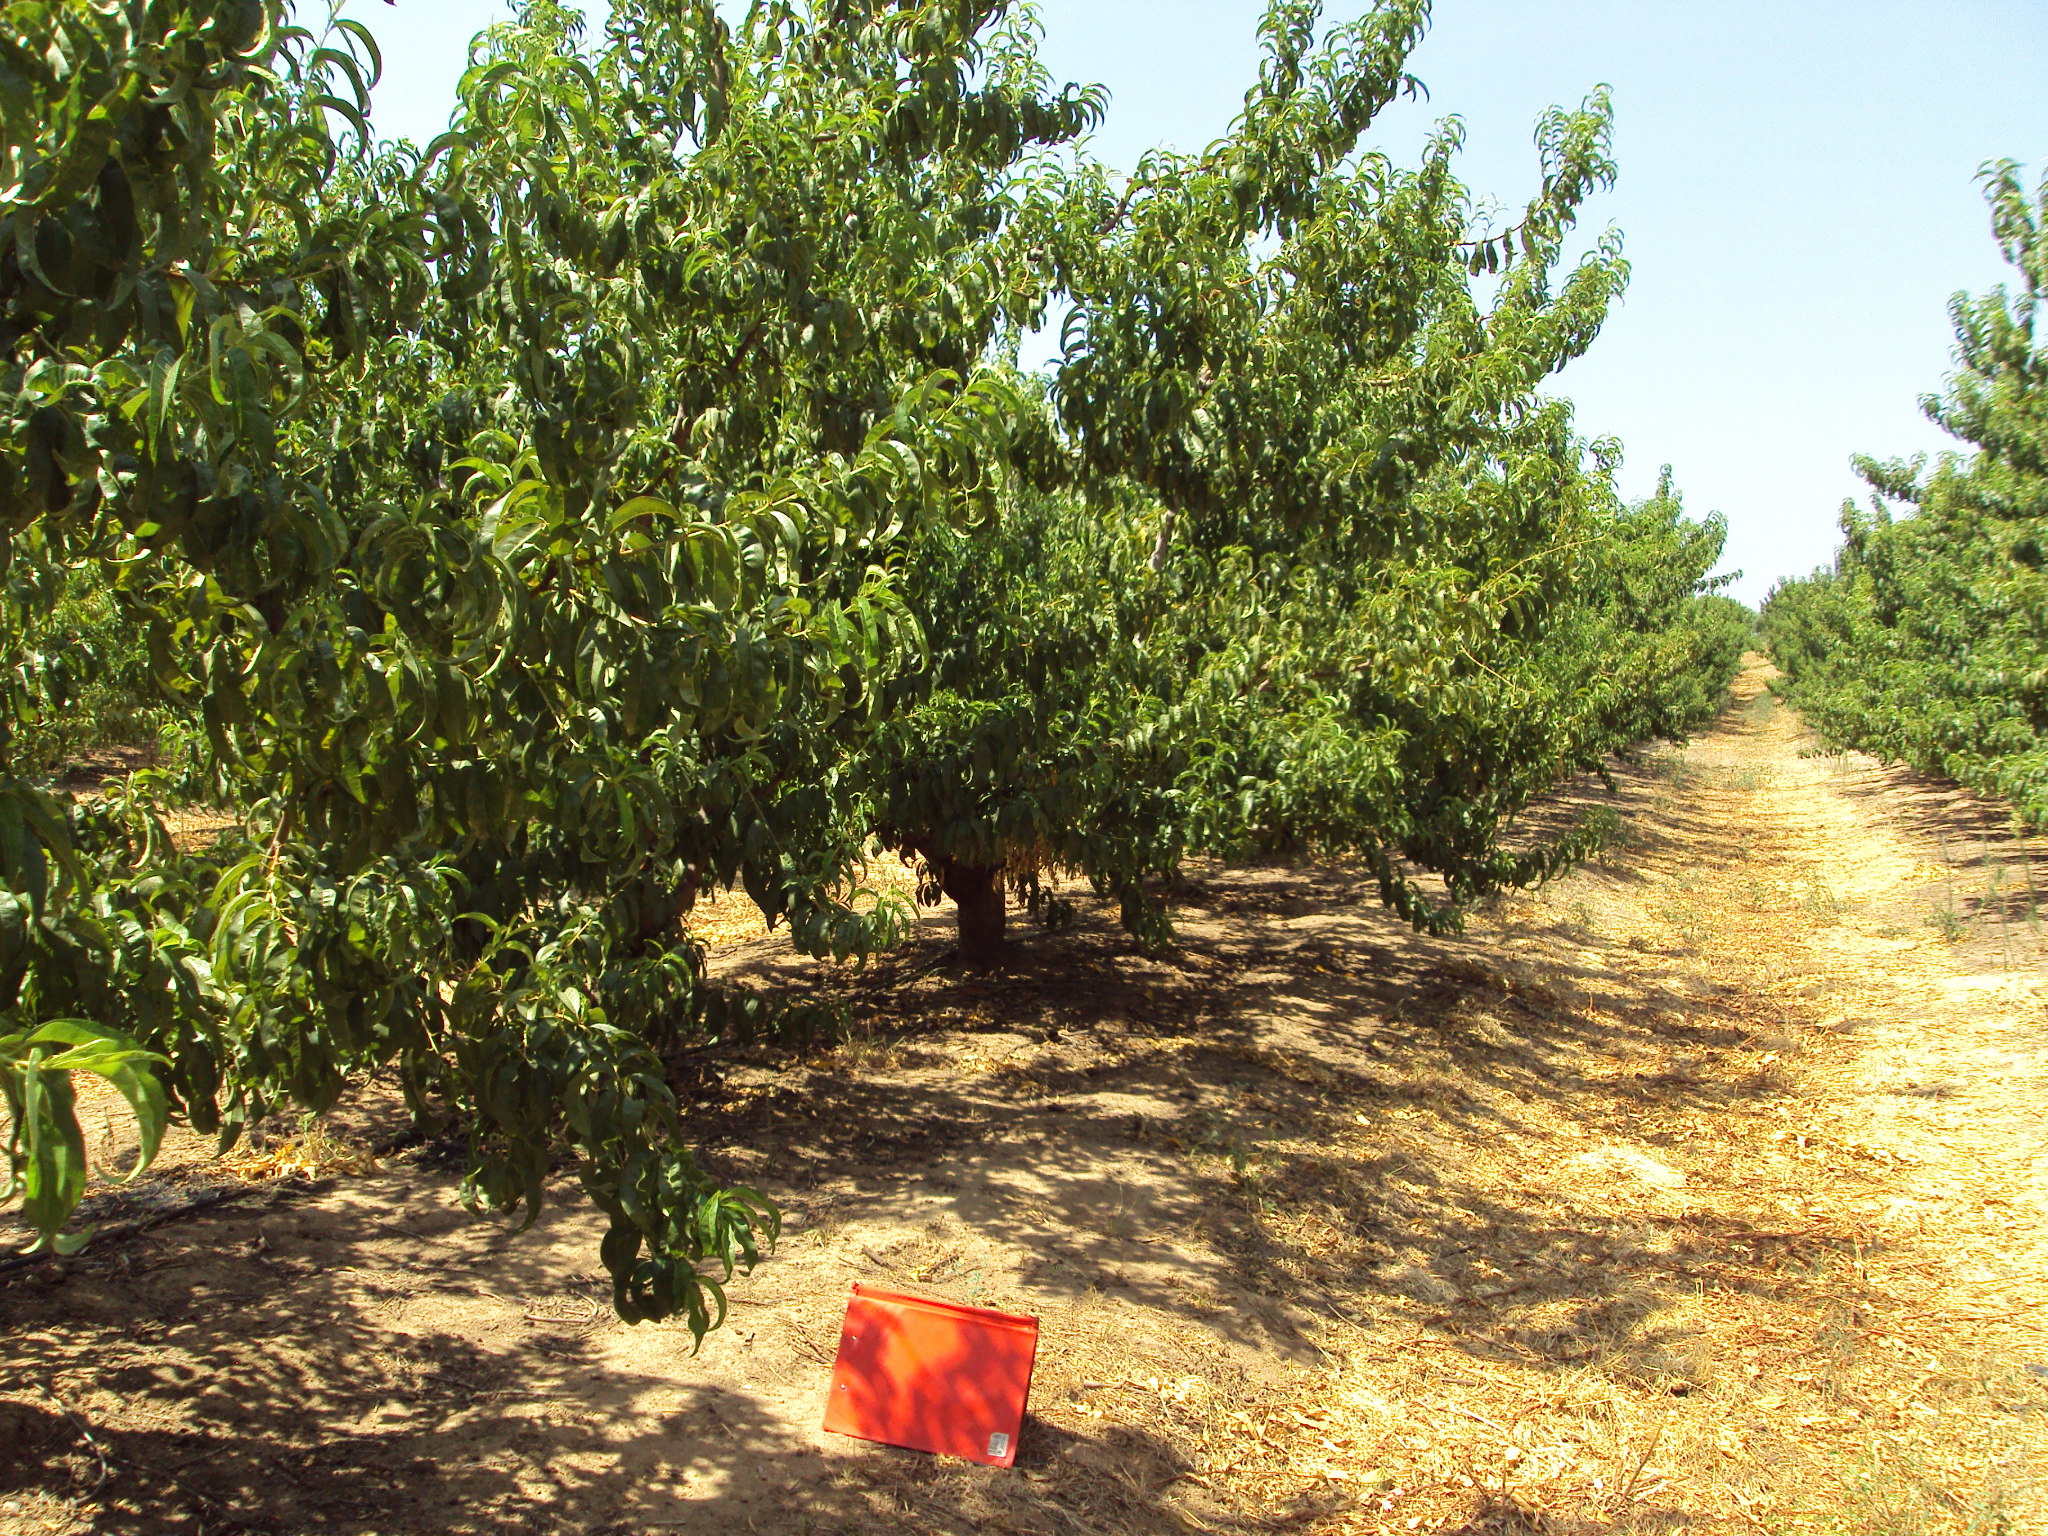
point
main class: Cropland
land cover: Other fruit trees and berries
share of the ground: 50 - 75 %
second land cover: Spontaneously vegetated surfaces
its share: > 75 %
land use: Agriculture (excluding fallow land and kitchen gardens)
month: July
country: ES
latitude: 37.3800
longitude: -7.0392
